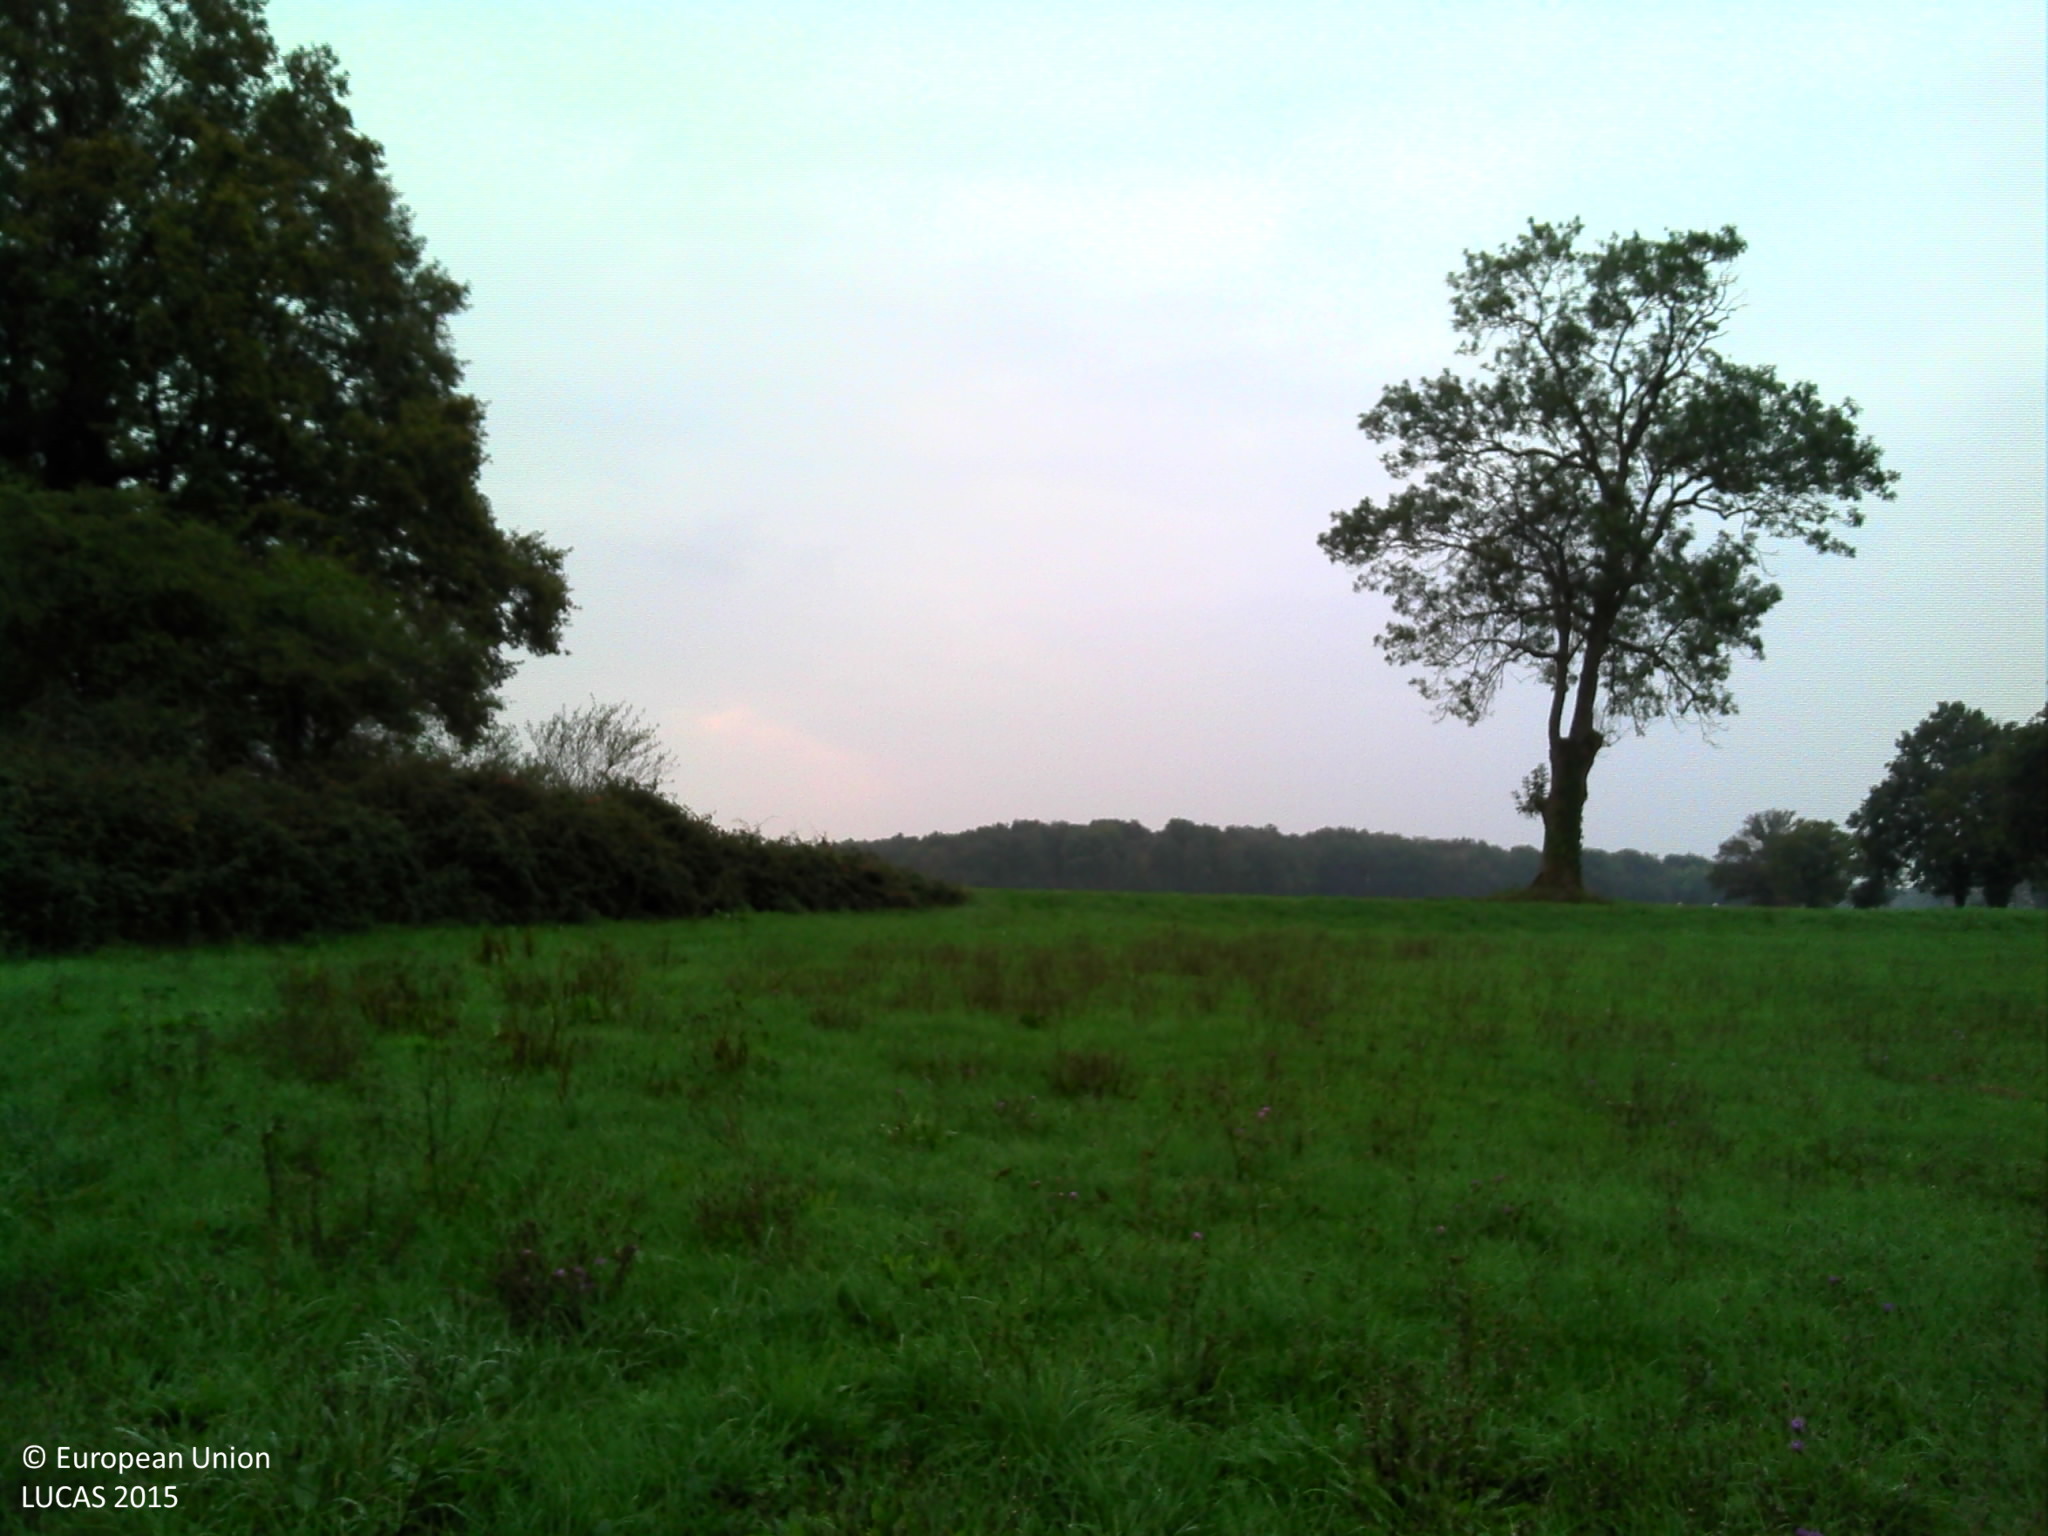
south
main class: Grassland
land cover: Grassland without tree/shrub cover
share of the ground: > 75 %
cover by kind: herbaceous plants 100 %
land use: Agriculture (excluding fallow land and kitchen gardens)
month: October
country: FR
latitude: 46.2564
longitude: 5.0862
